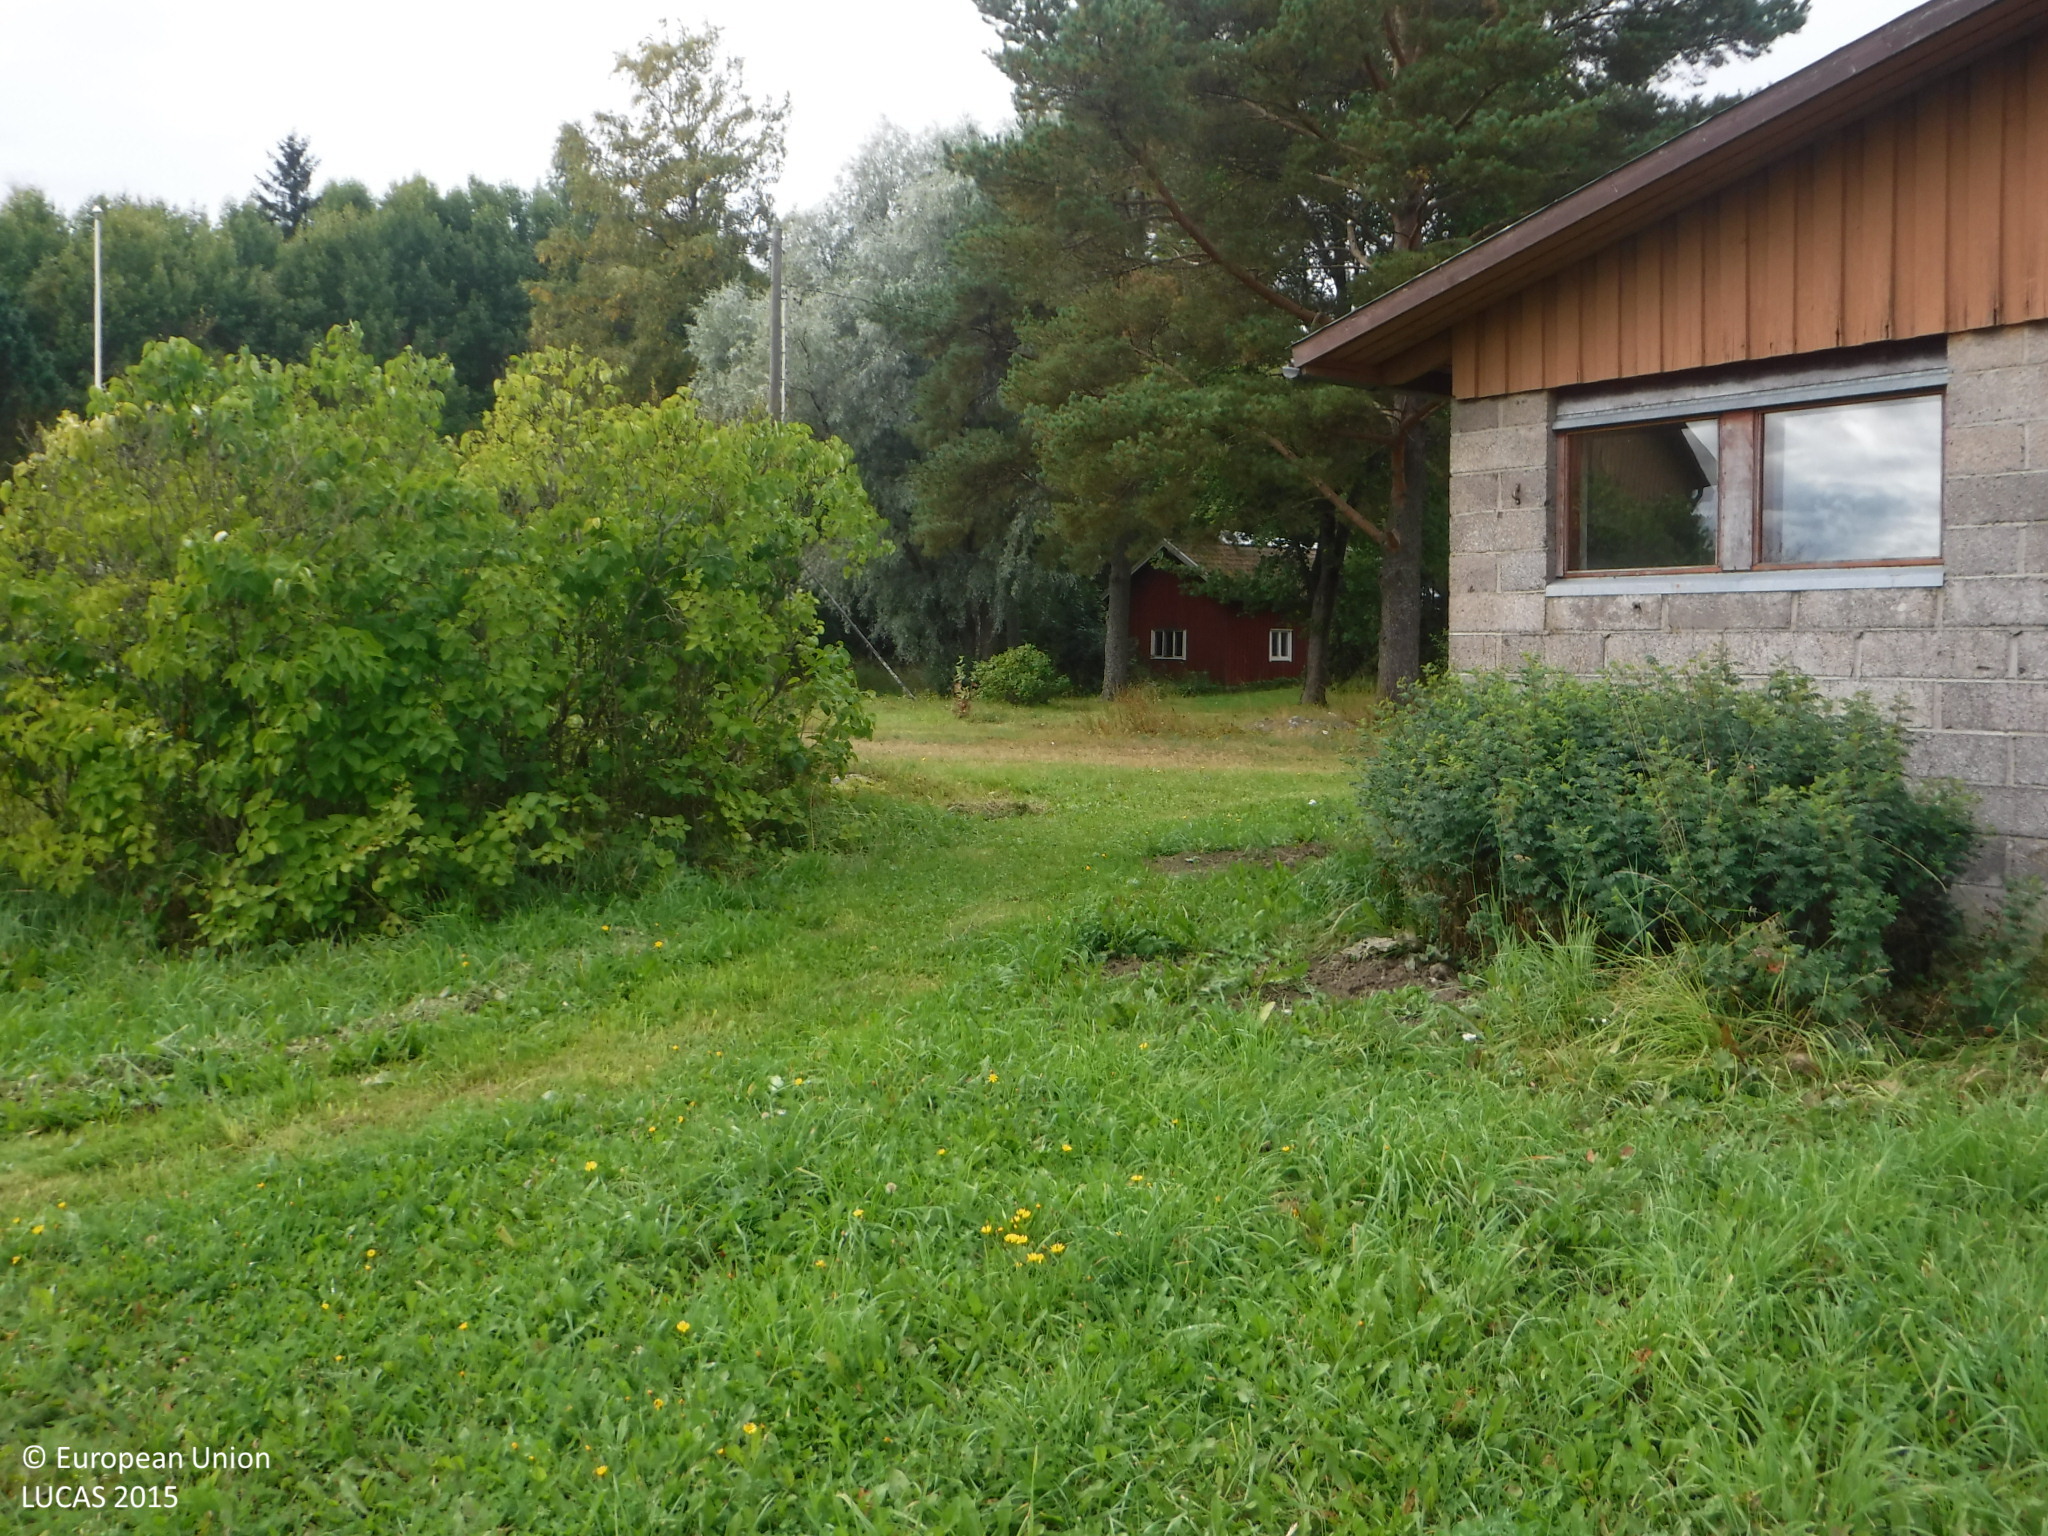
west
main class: Cropland
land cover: Common wheat
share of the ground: > 75 %
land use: Agriculture (excluding fallow land and kitchen gardens)
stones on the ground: < 10 %
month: September
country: FI
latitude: 61.3408
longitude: 23.1017
